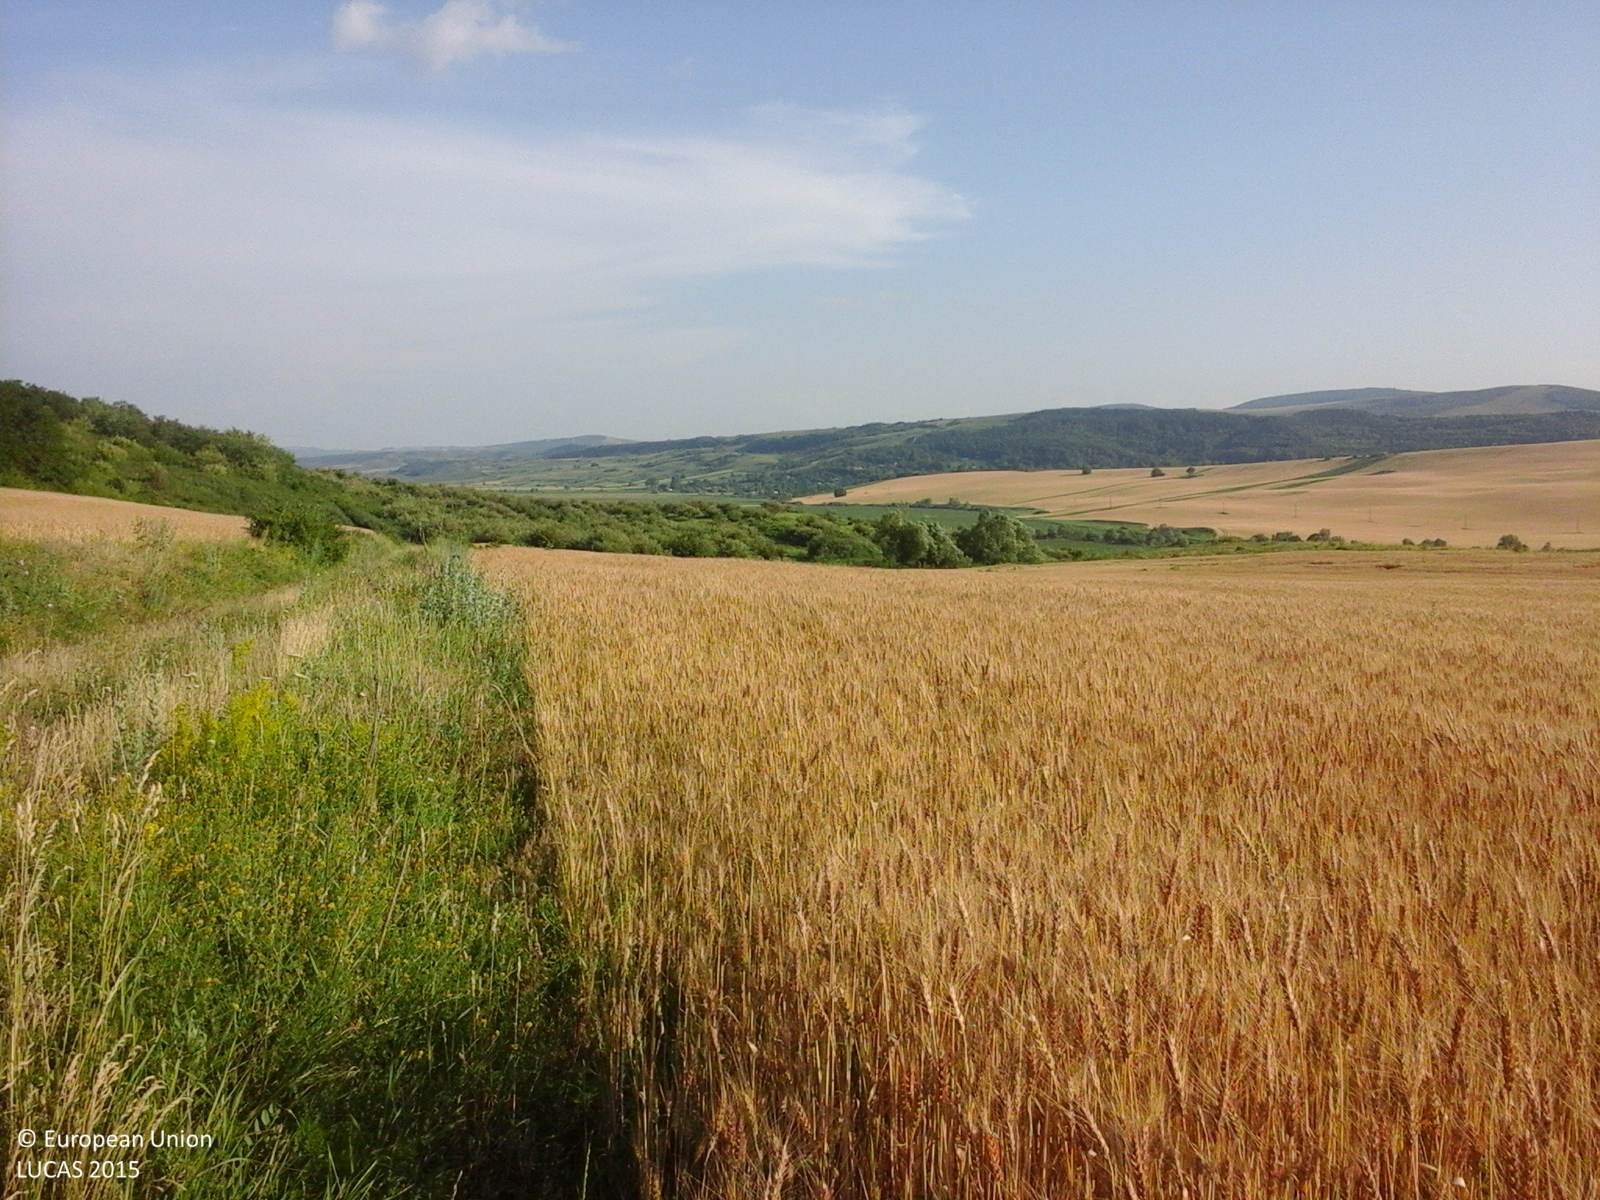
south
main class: Cropland
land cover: Common wheat
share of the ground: > 75 %
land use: Agriculture (excluding fallow land and kitchen gardens)
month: June
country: RO
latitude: 46.5469
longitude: 27.4145
